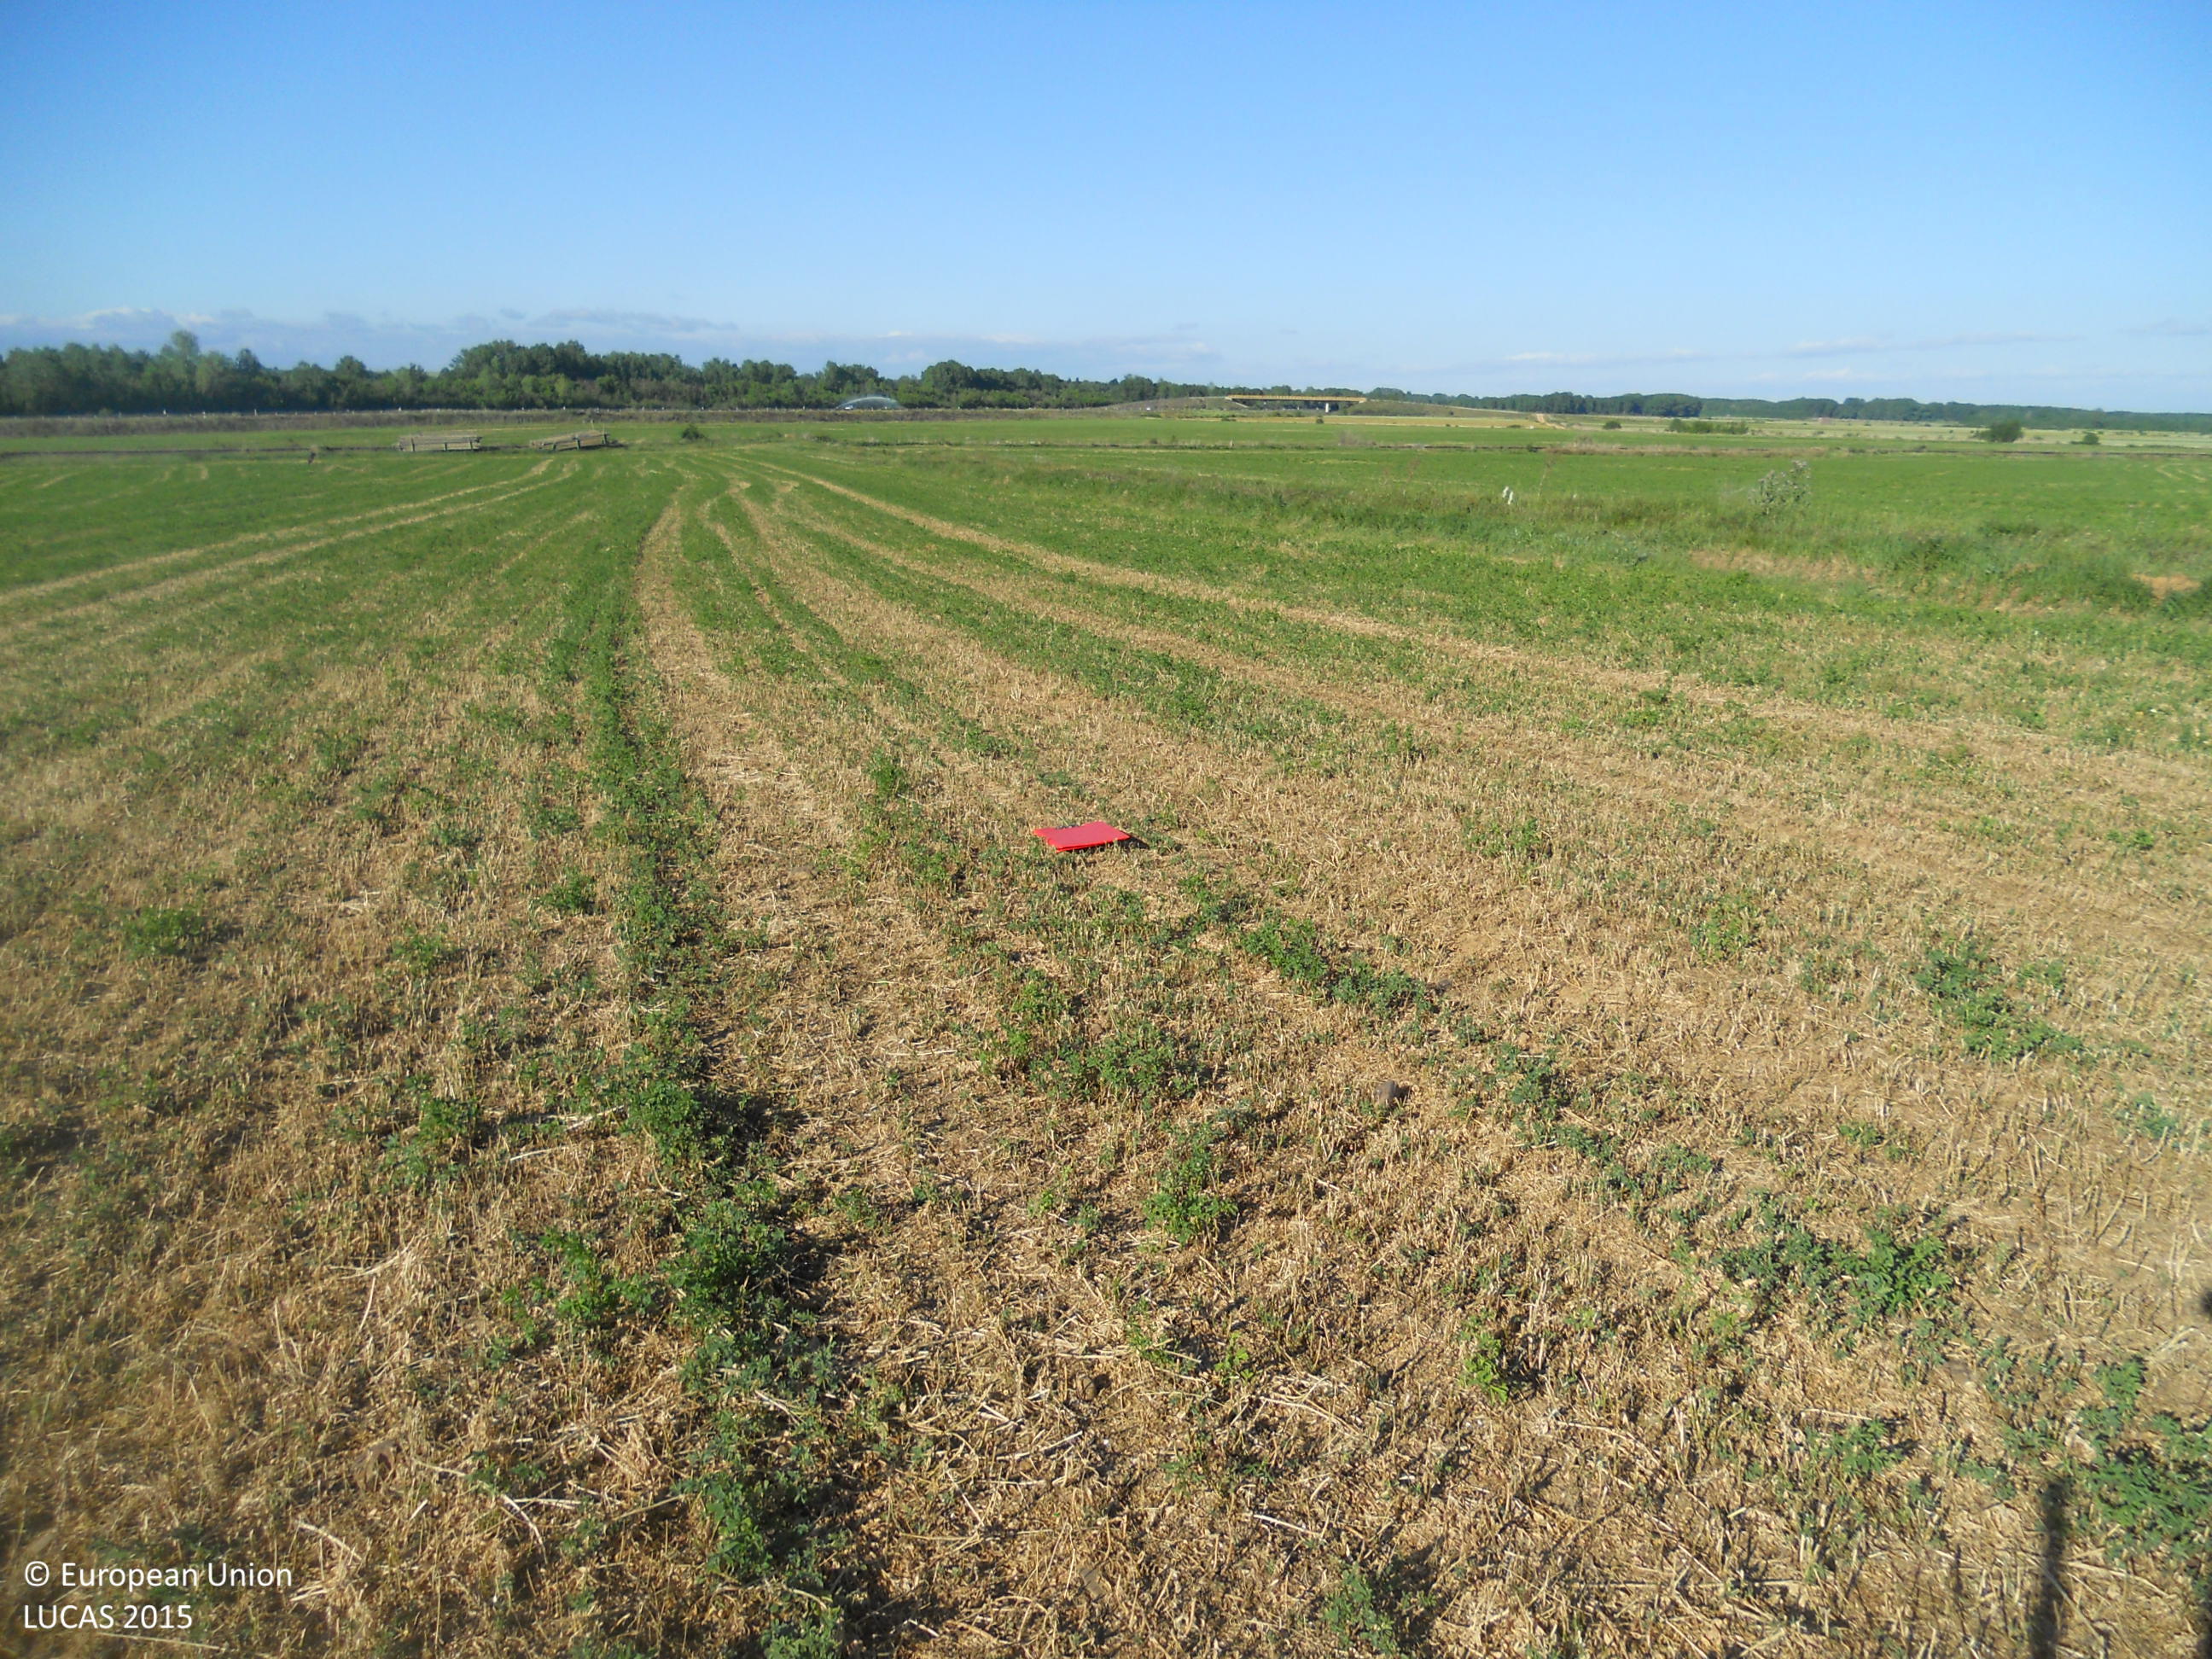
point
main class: Cropland
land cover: Lucerne
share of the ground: > 75 %
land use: Agriculture (excluding fallow land and kitchen gardens)
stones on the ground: < 10 %
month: May
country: ES
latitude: 42.3993
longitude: -4.3220
